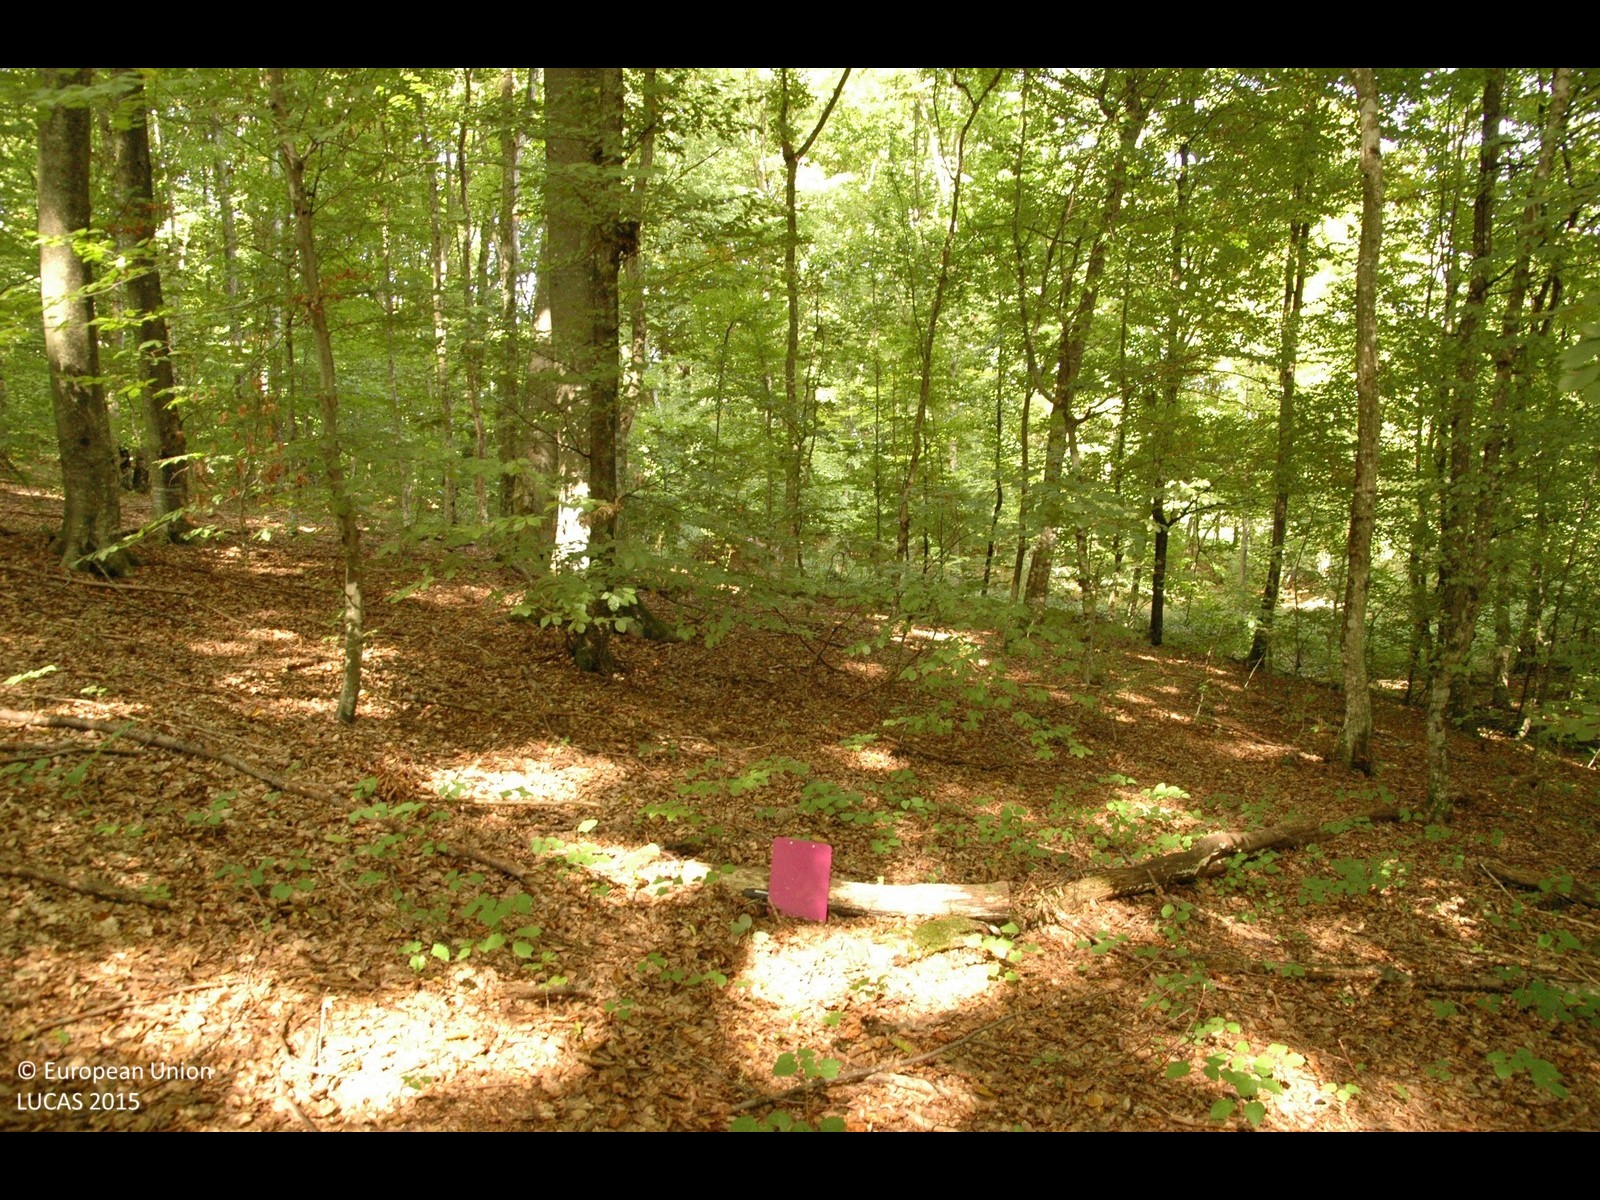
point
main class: Woodland
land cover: Broadleaved woodland
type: beech forest
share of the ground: > 75 %
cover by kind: broadleaved forest trees 100 %
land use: Forestry
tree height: > 5 m
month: September
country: HR
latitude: 45.5934
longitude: 15.8809
